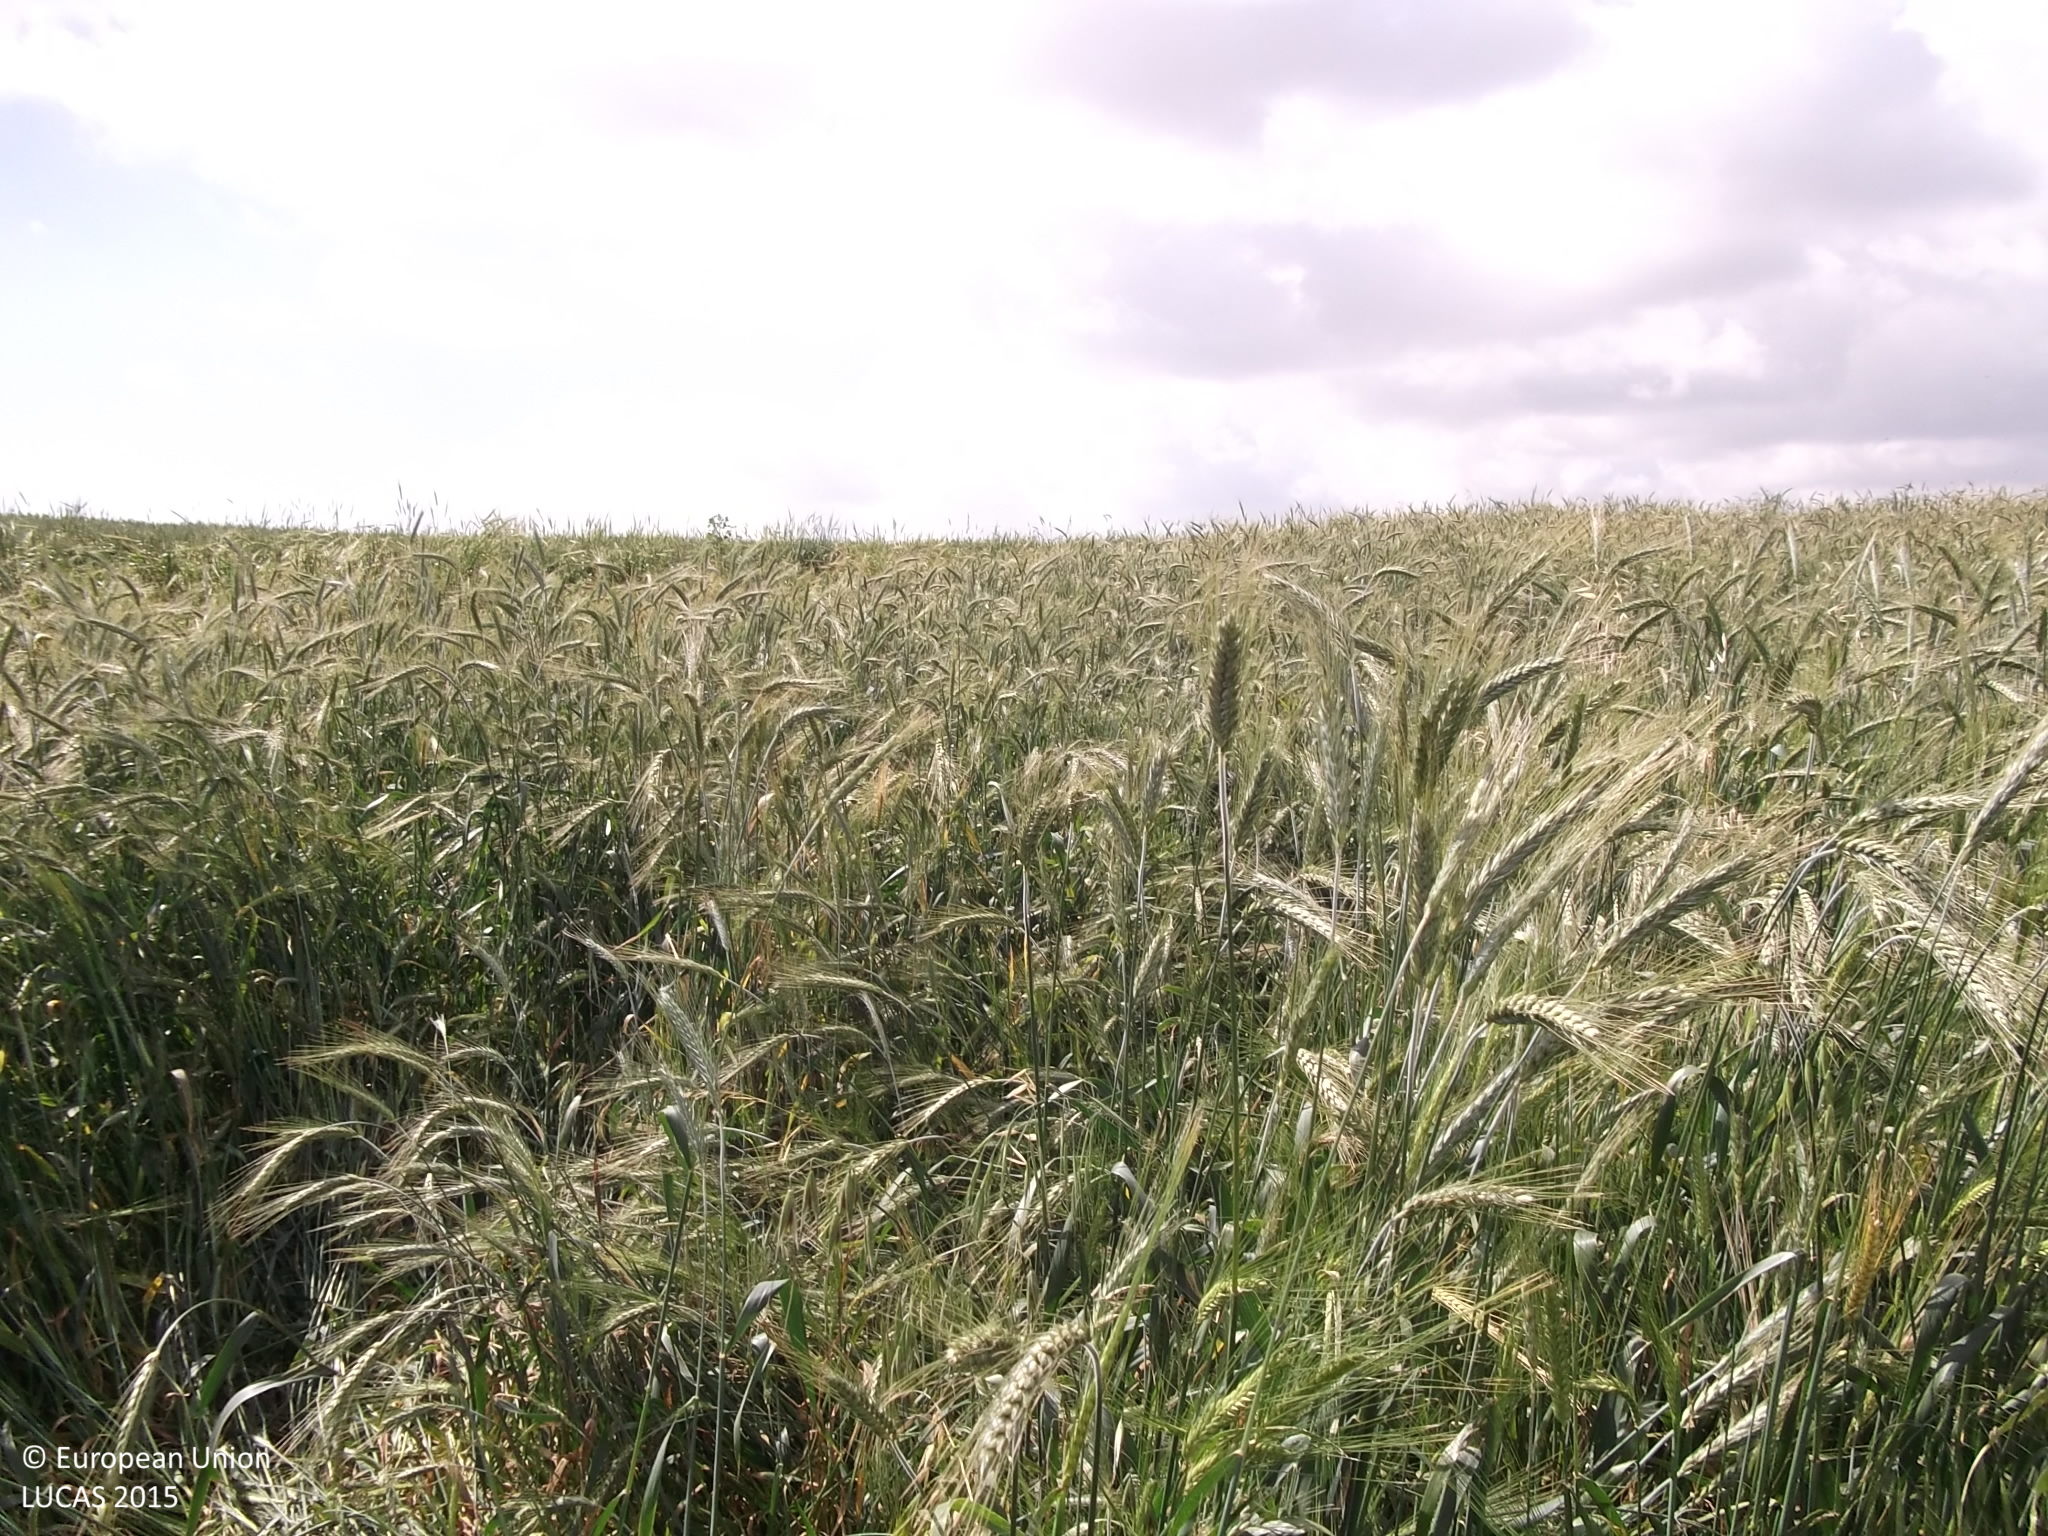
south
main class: Cropland
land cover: Common wheat
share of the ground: > 75 %
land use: Agriculture (excluding fallow land and kitchen gardens)
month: April
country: CY
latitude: 34.9806
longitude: 33.5839
